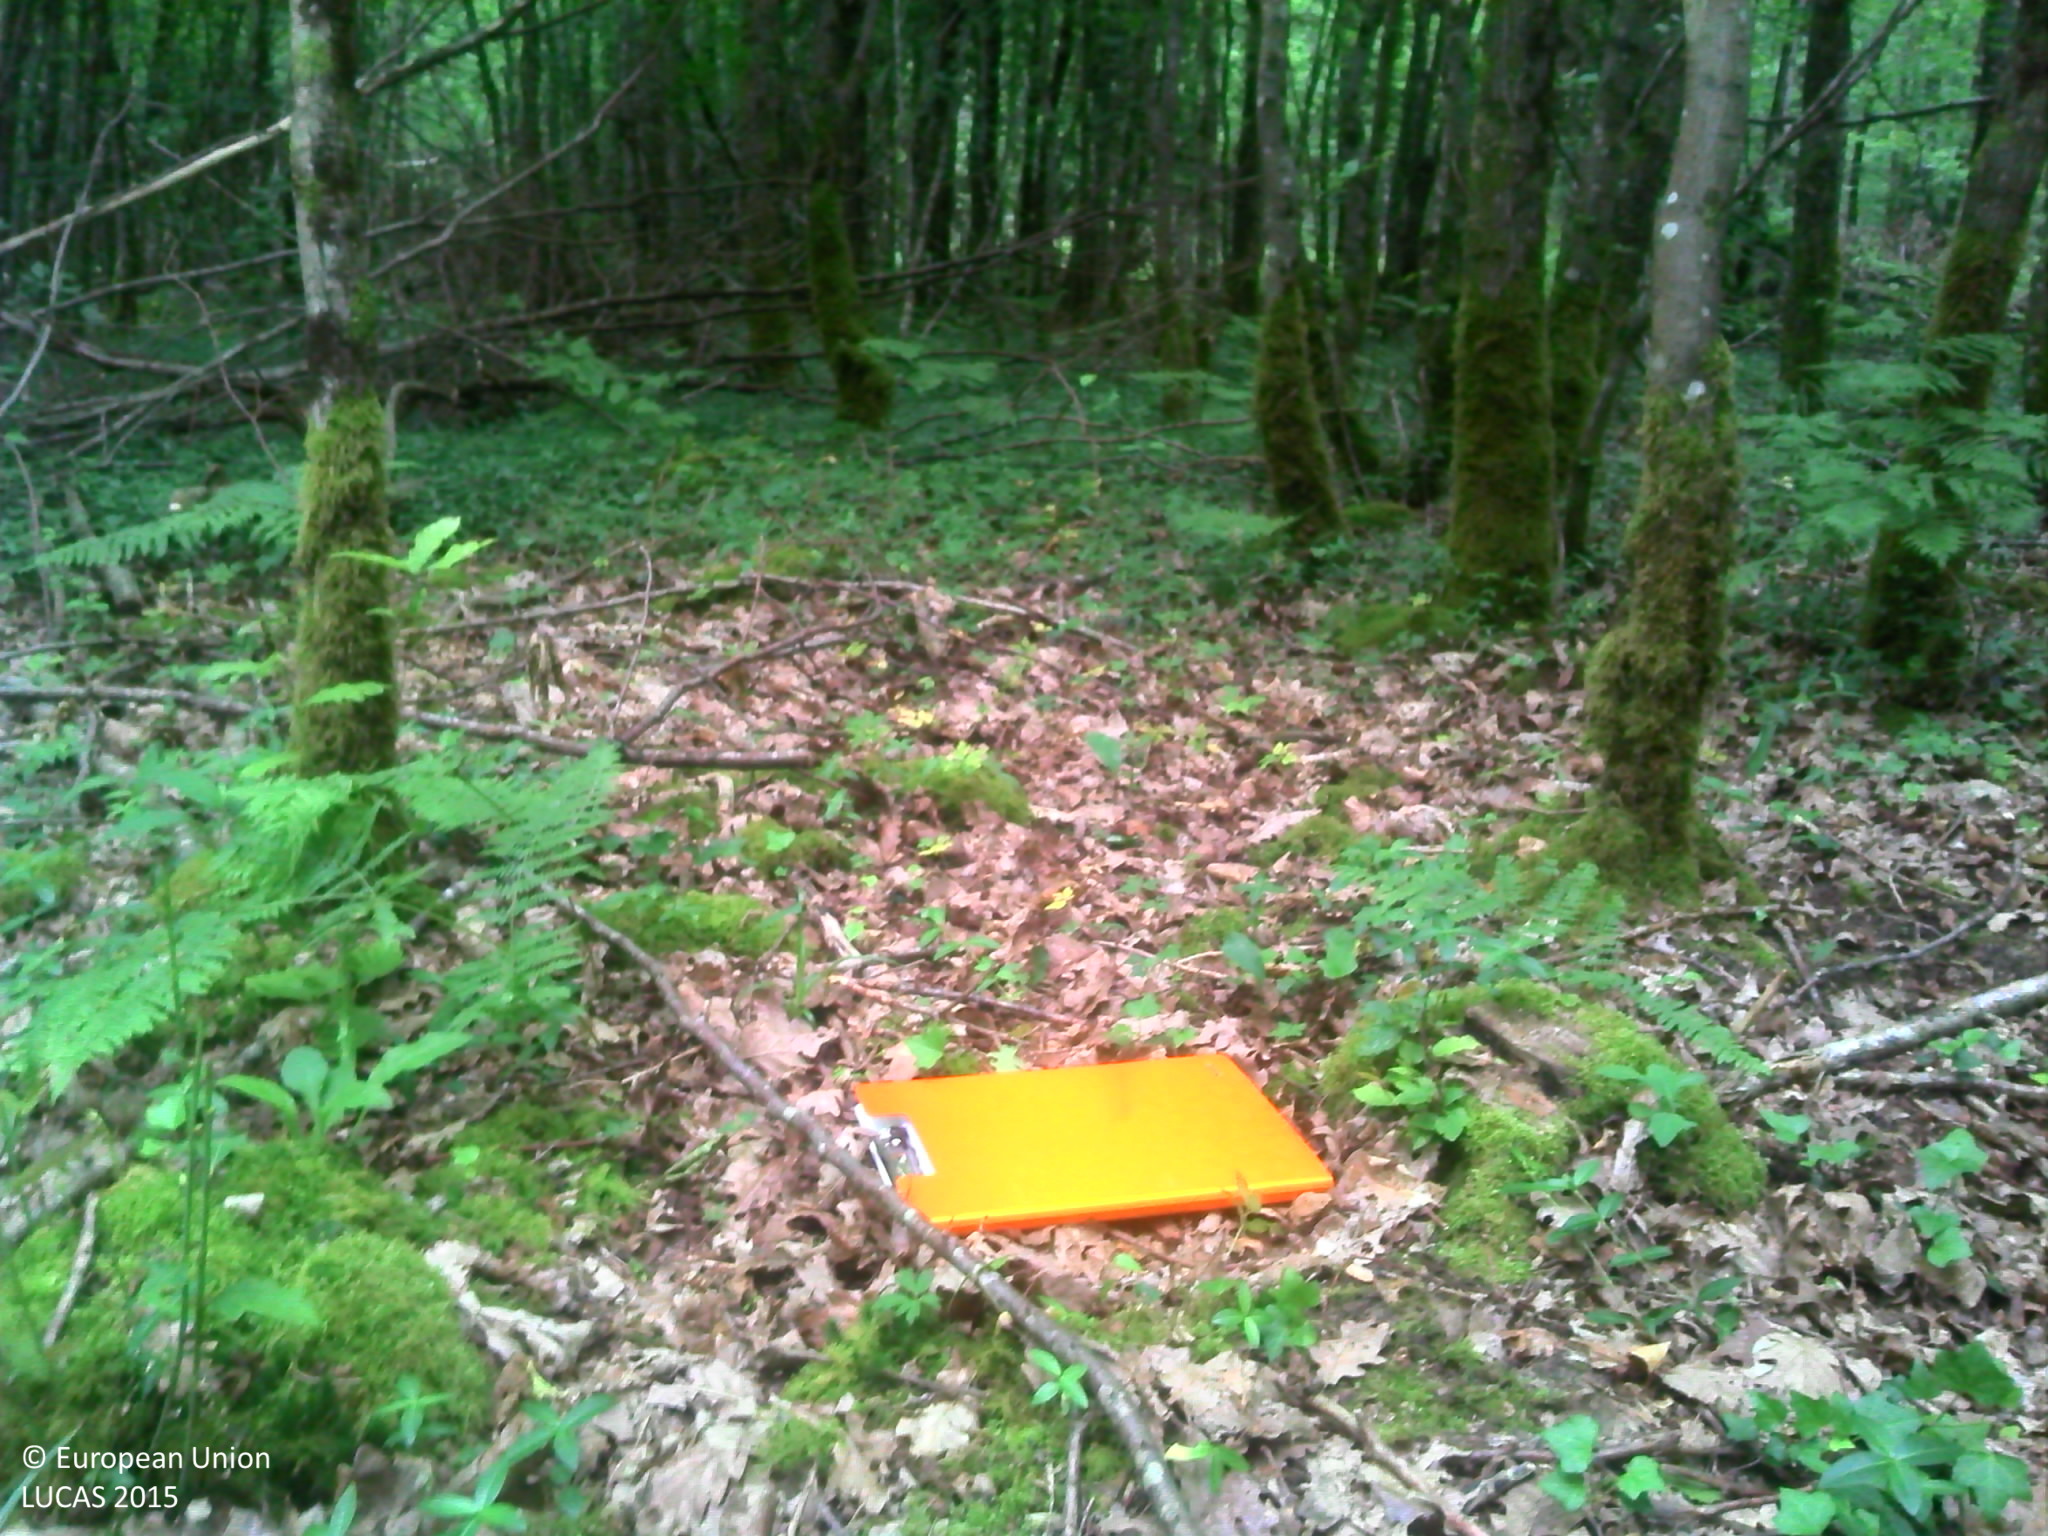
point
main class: Woodland
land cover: Broadleaved woodland
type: mesophytic deciduous forest
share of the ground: > 75 %
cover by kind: broadleaved forest trees 90 %, herbaceous plants 10 %
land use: Forestry
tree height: > 5 m
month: June
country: FR
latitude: 48.5379
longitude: 4.8921
